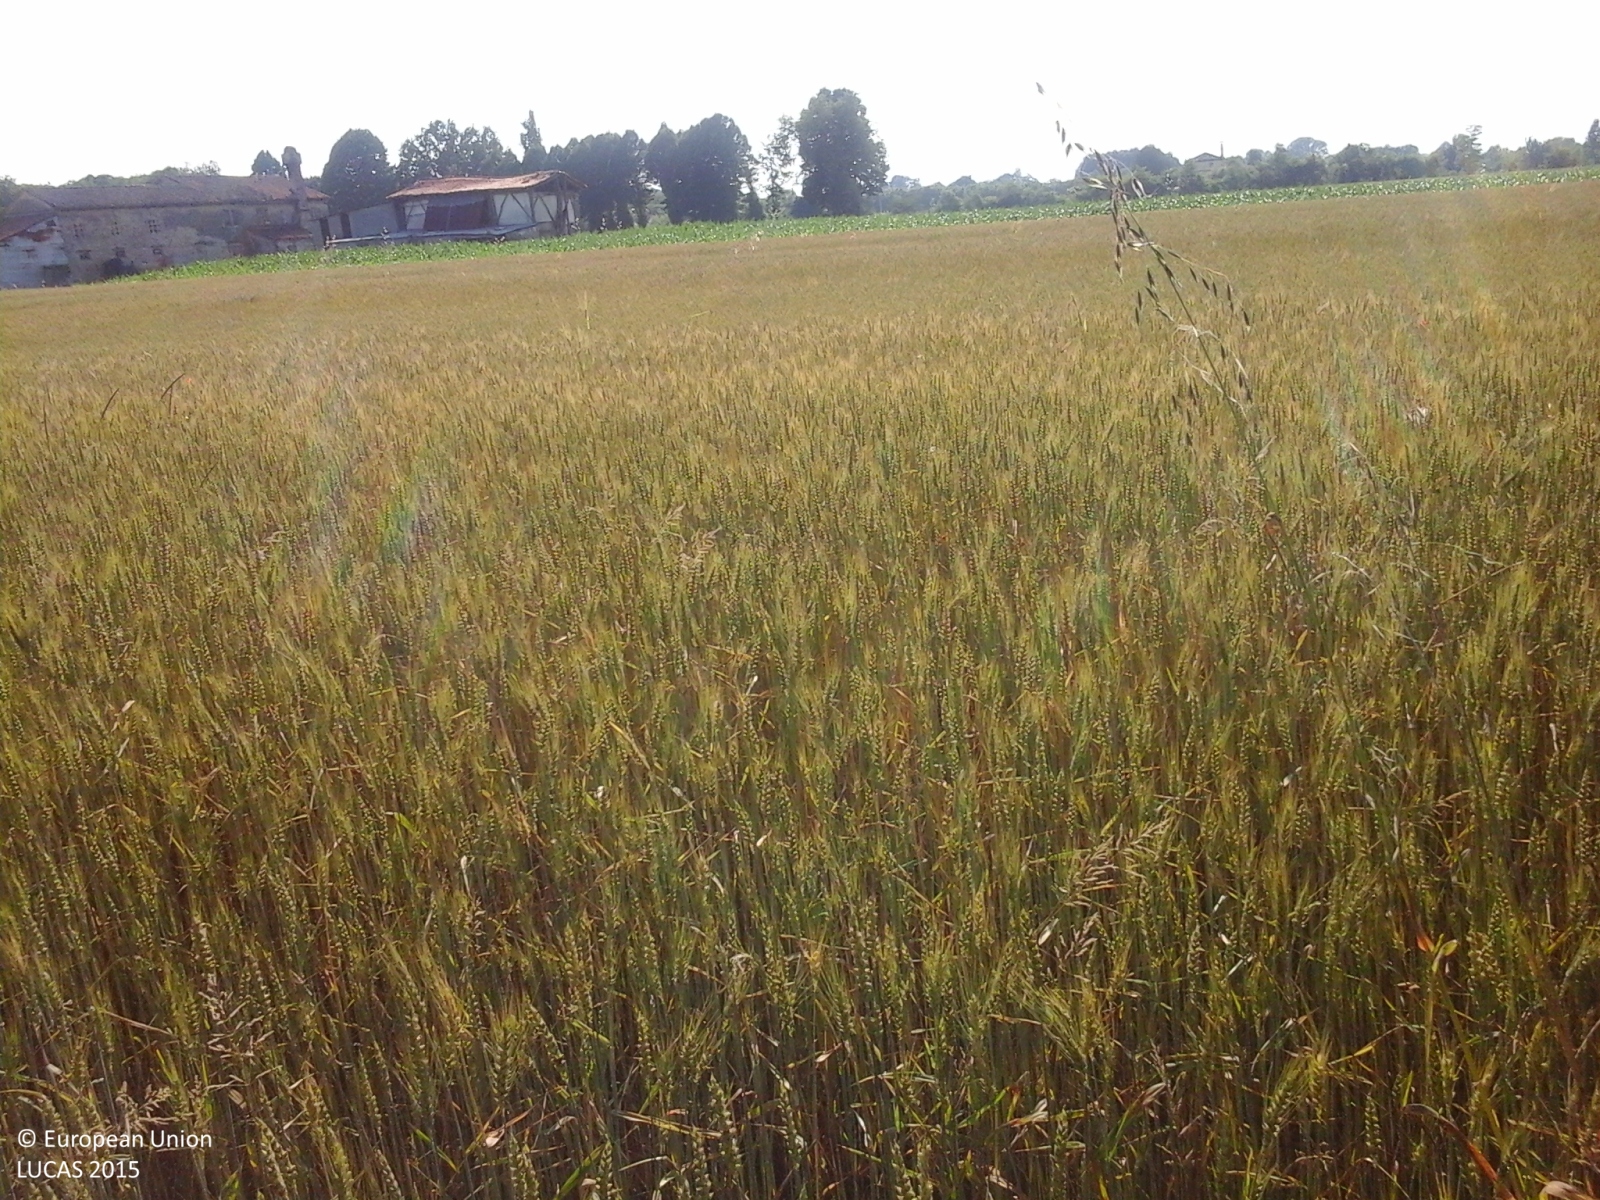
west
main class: Cropland
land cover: Common wheat
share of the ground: > 75 %
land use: Agriculture (excluding fallow land and kitchen gardens)
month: June
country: IT
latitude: 45.6052
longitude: 12.3172
